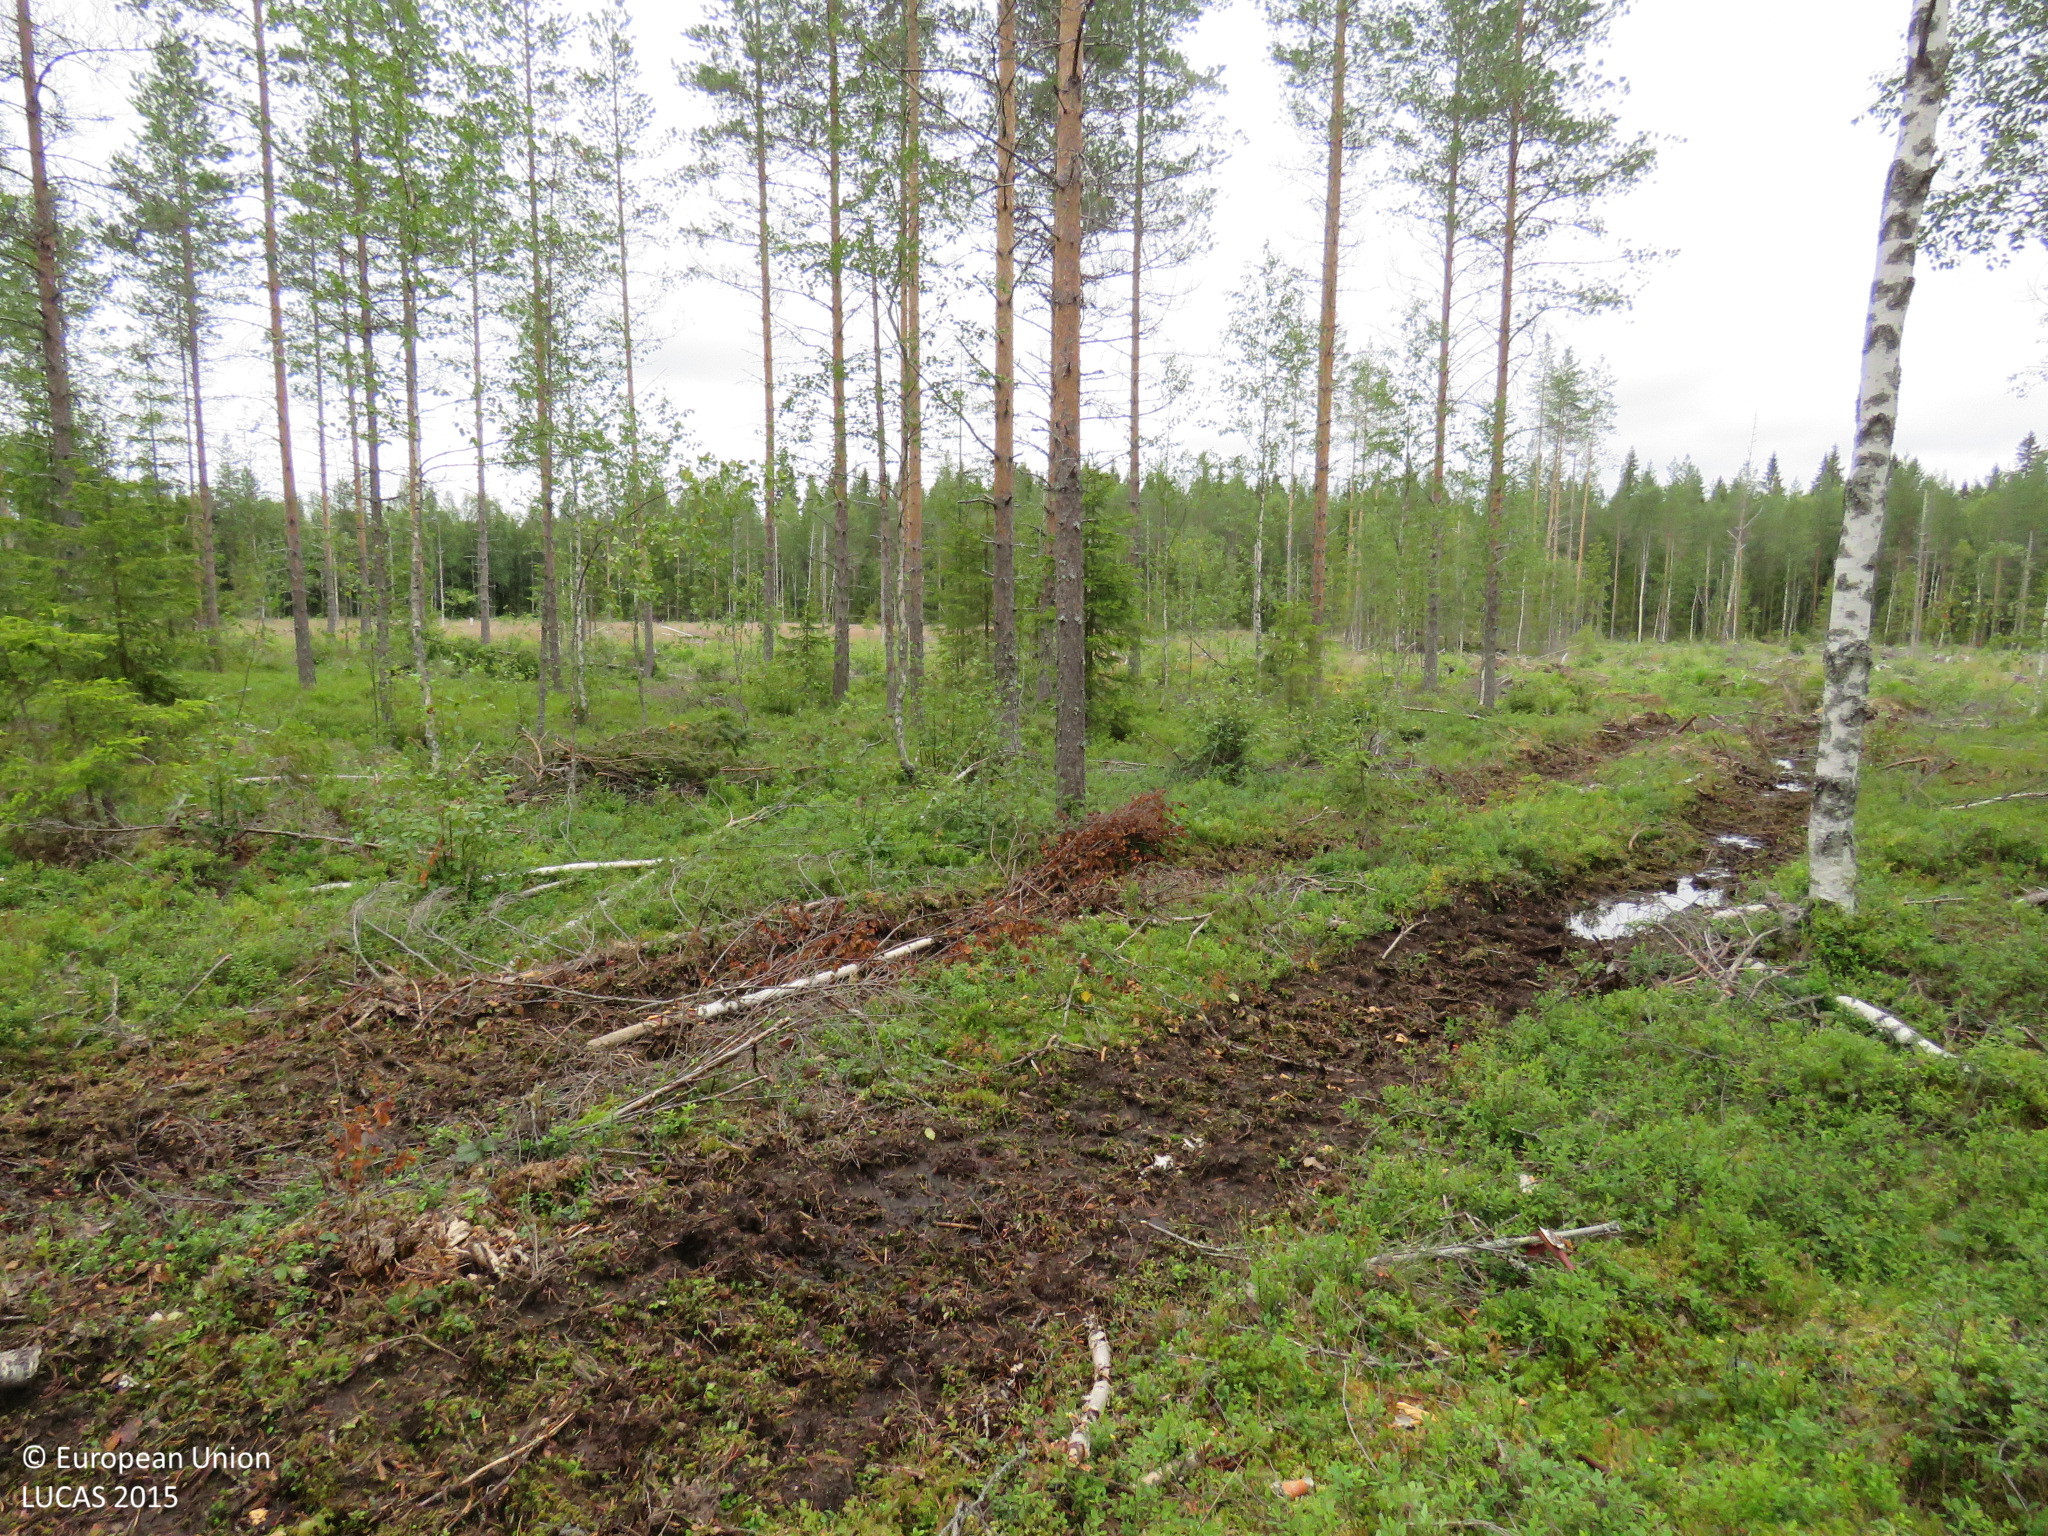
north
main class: Woodland
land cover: Other mixed woodland
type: boreal forest
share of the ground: 50 - 75 %
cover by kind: coniferous forest trees 40 %, broadleaved forest trees 25 %, shrubs 20 %, lichens and mosses 10 %, unconsolidated bare surface 5 %
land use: Forestry
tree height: > 5 m
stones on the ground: < 10 %
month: July
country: FI
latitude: 64.6087
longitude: 26.9513
